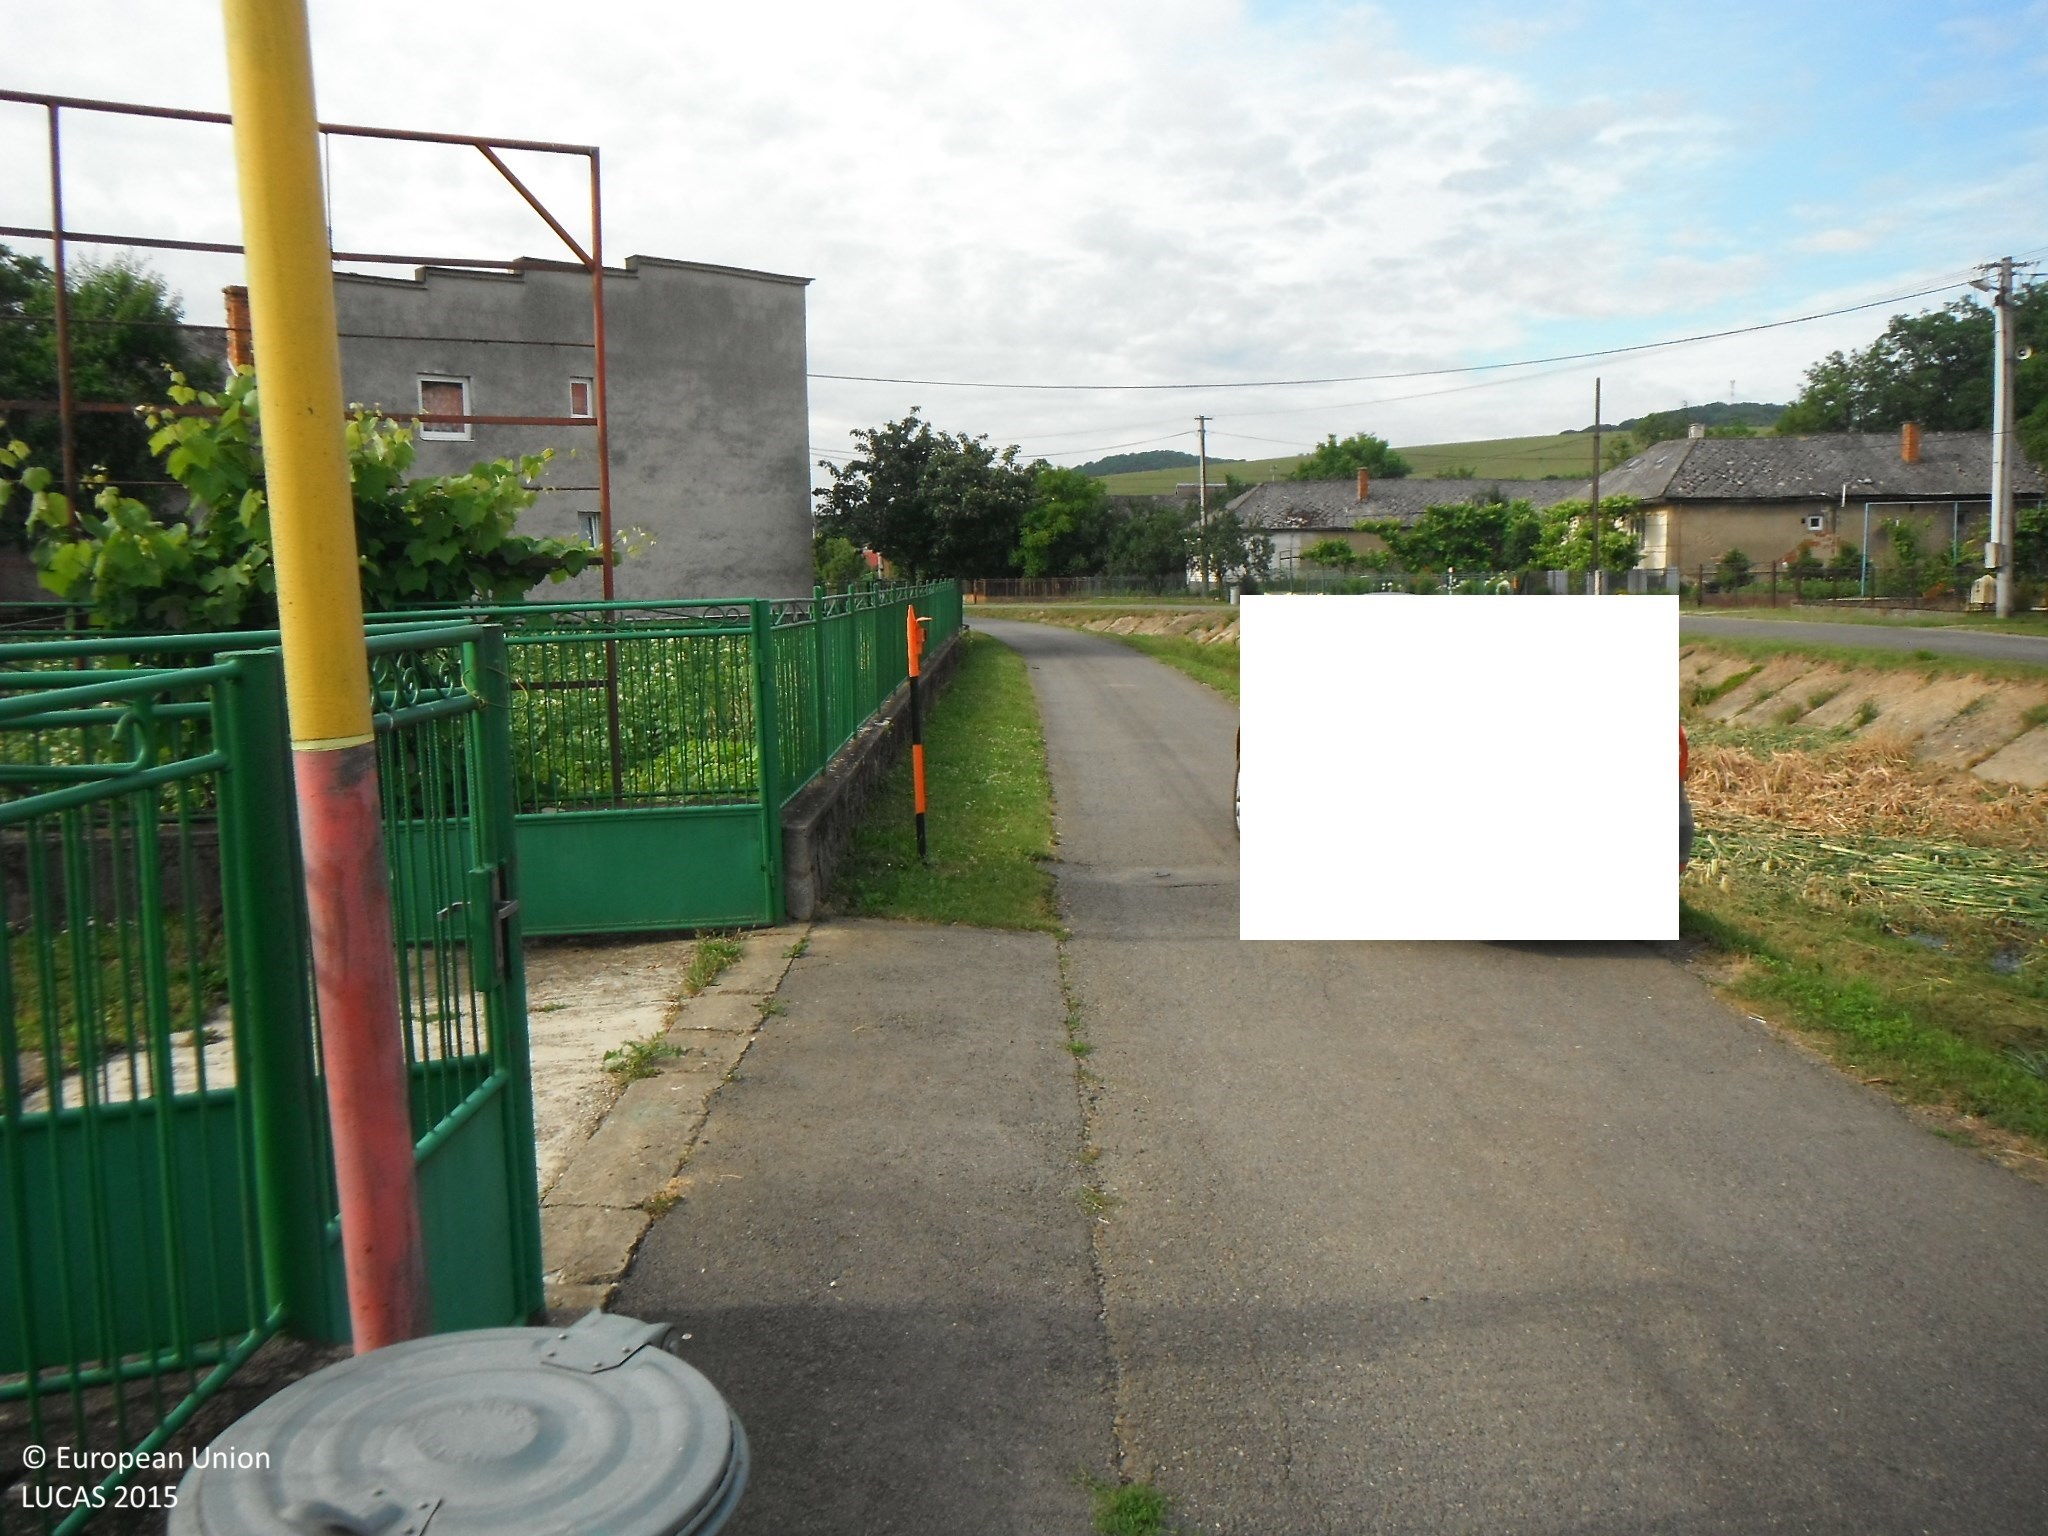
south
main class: Grassland
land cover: Grassland without tree/shrub cover
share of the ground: > 75 %
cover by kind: herbaceous plants 100 %
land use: Residential
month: June
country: SK
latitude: 48.9493
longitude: 21.6433
